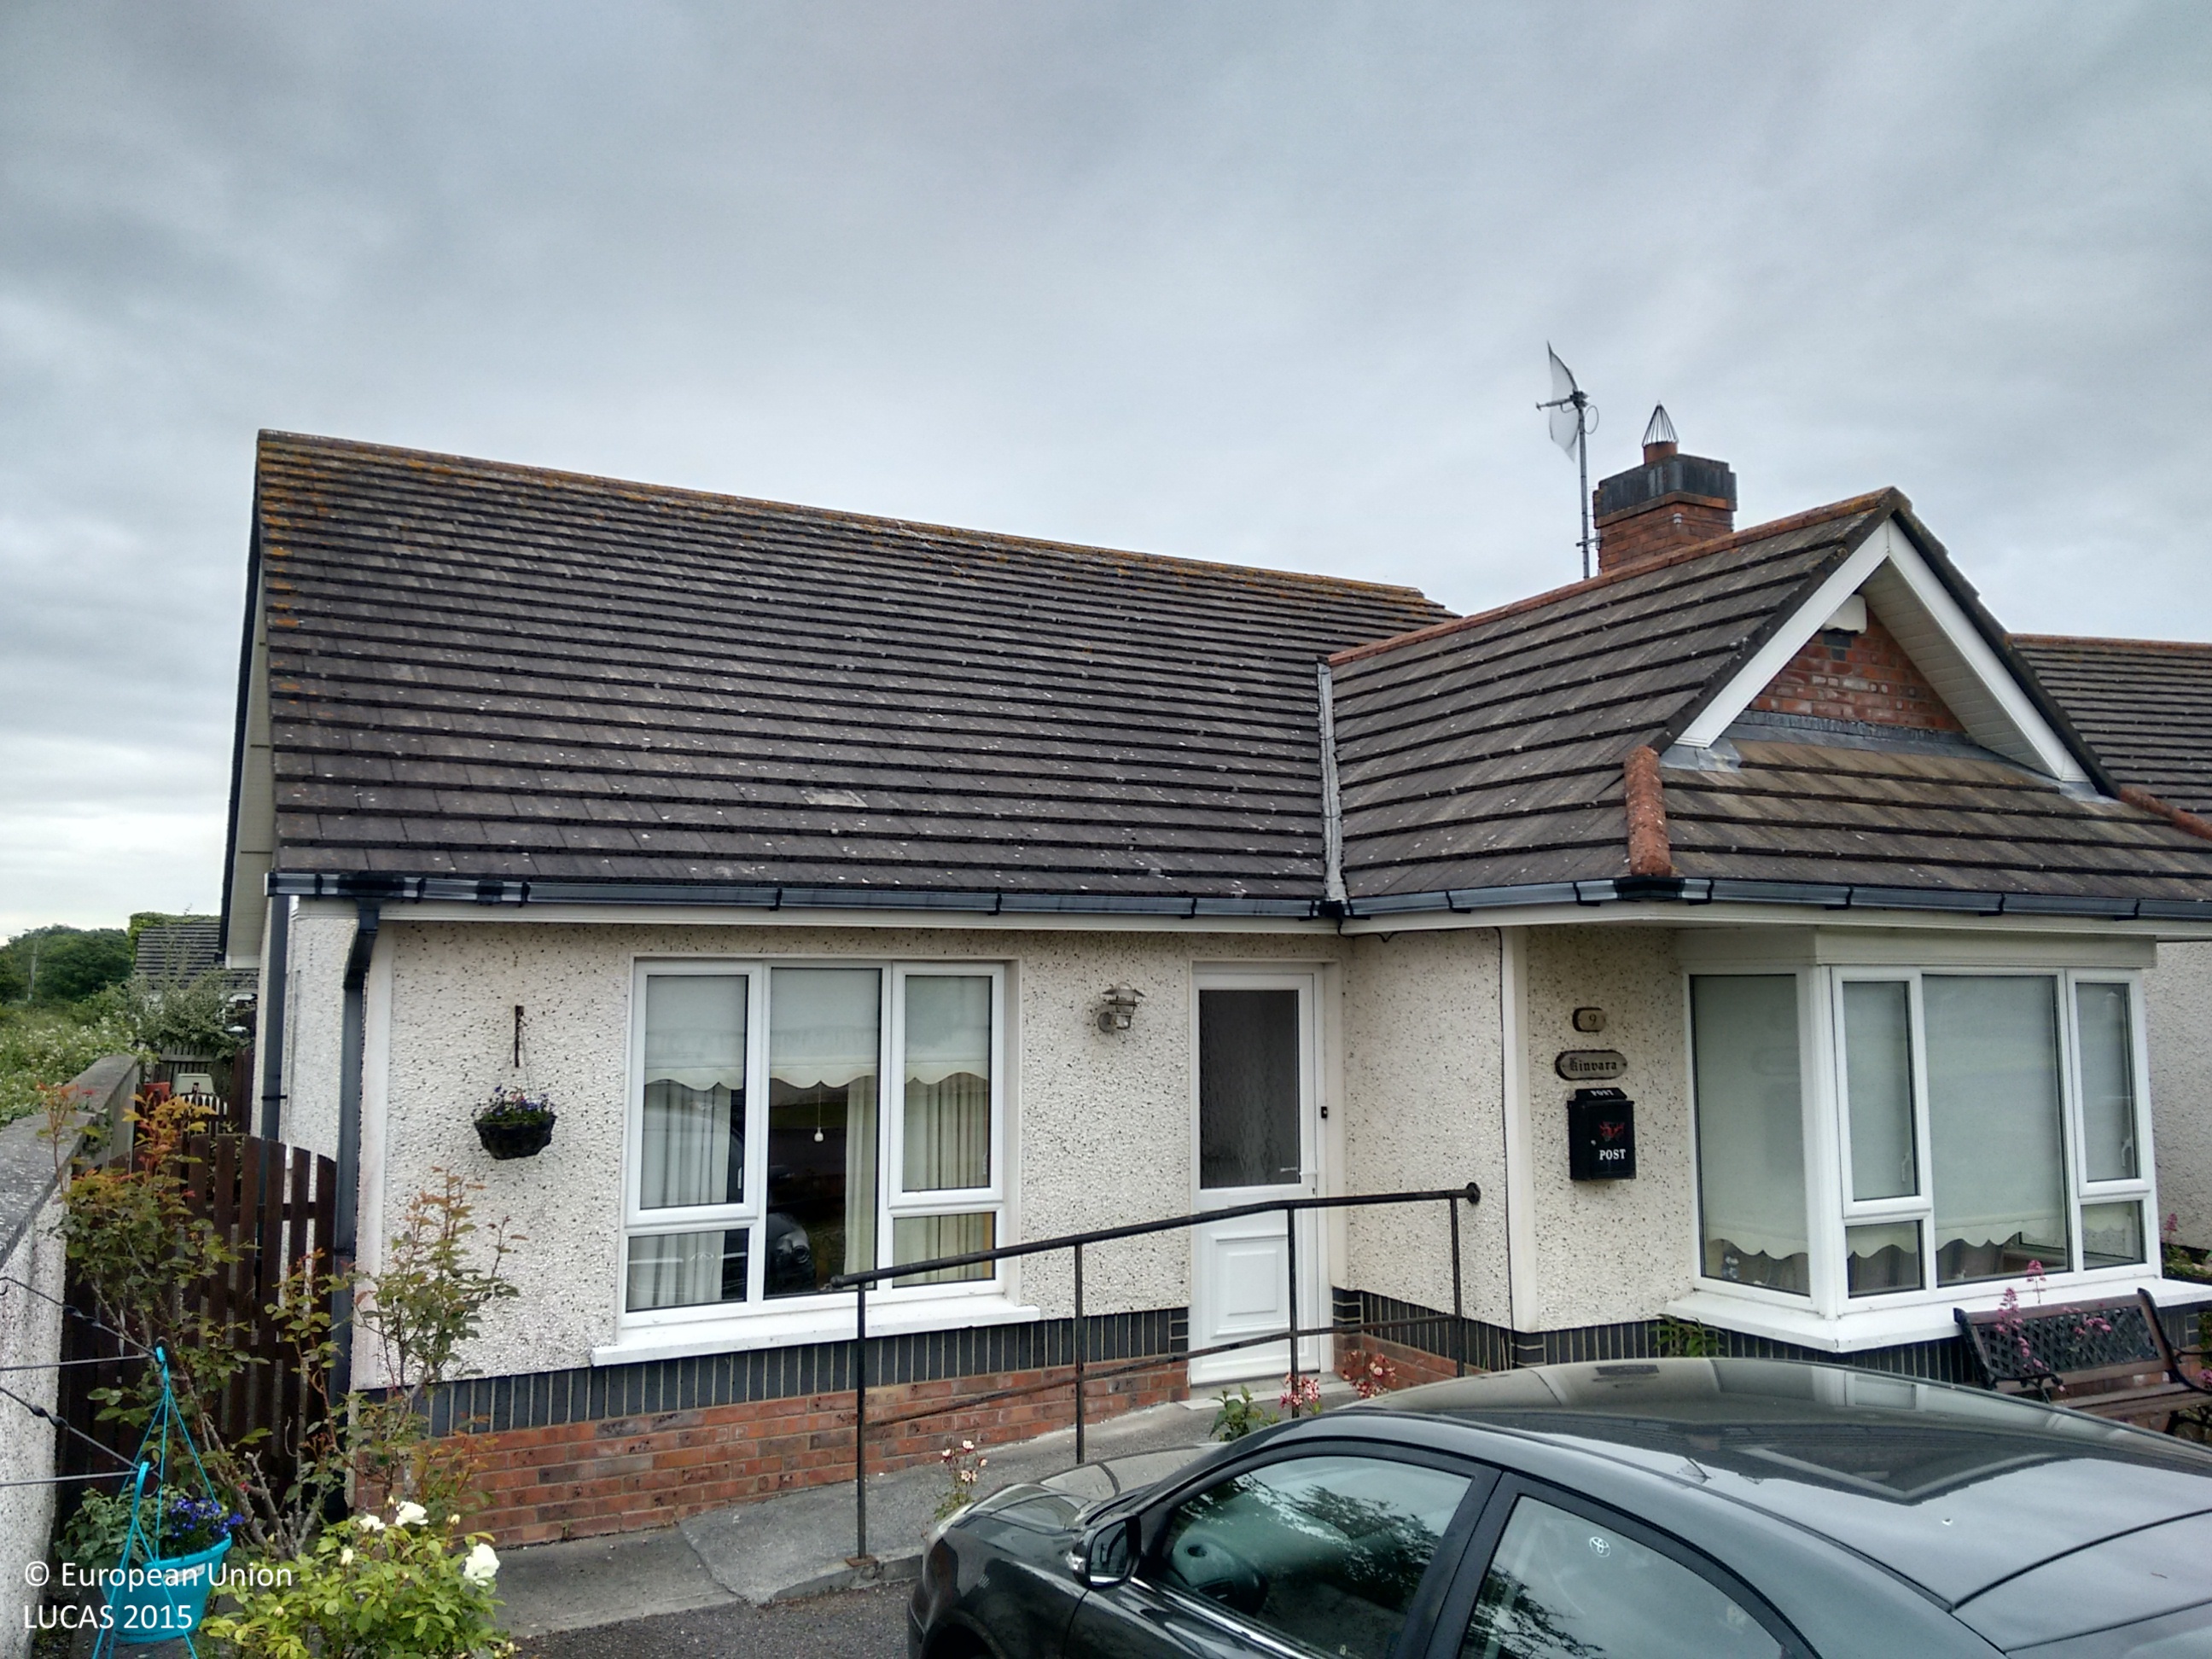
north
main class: Grassland
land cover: Grassland without tree/shrub cover
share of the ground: > 75 %
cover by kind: herbaceous plants 100 %
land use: Agriculture (excluding fallow land and kitchen gardens)
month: June
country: IE
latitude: 53.7074
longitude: -6.2533
